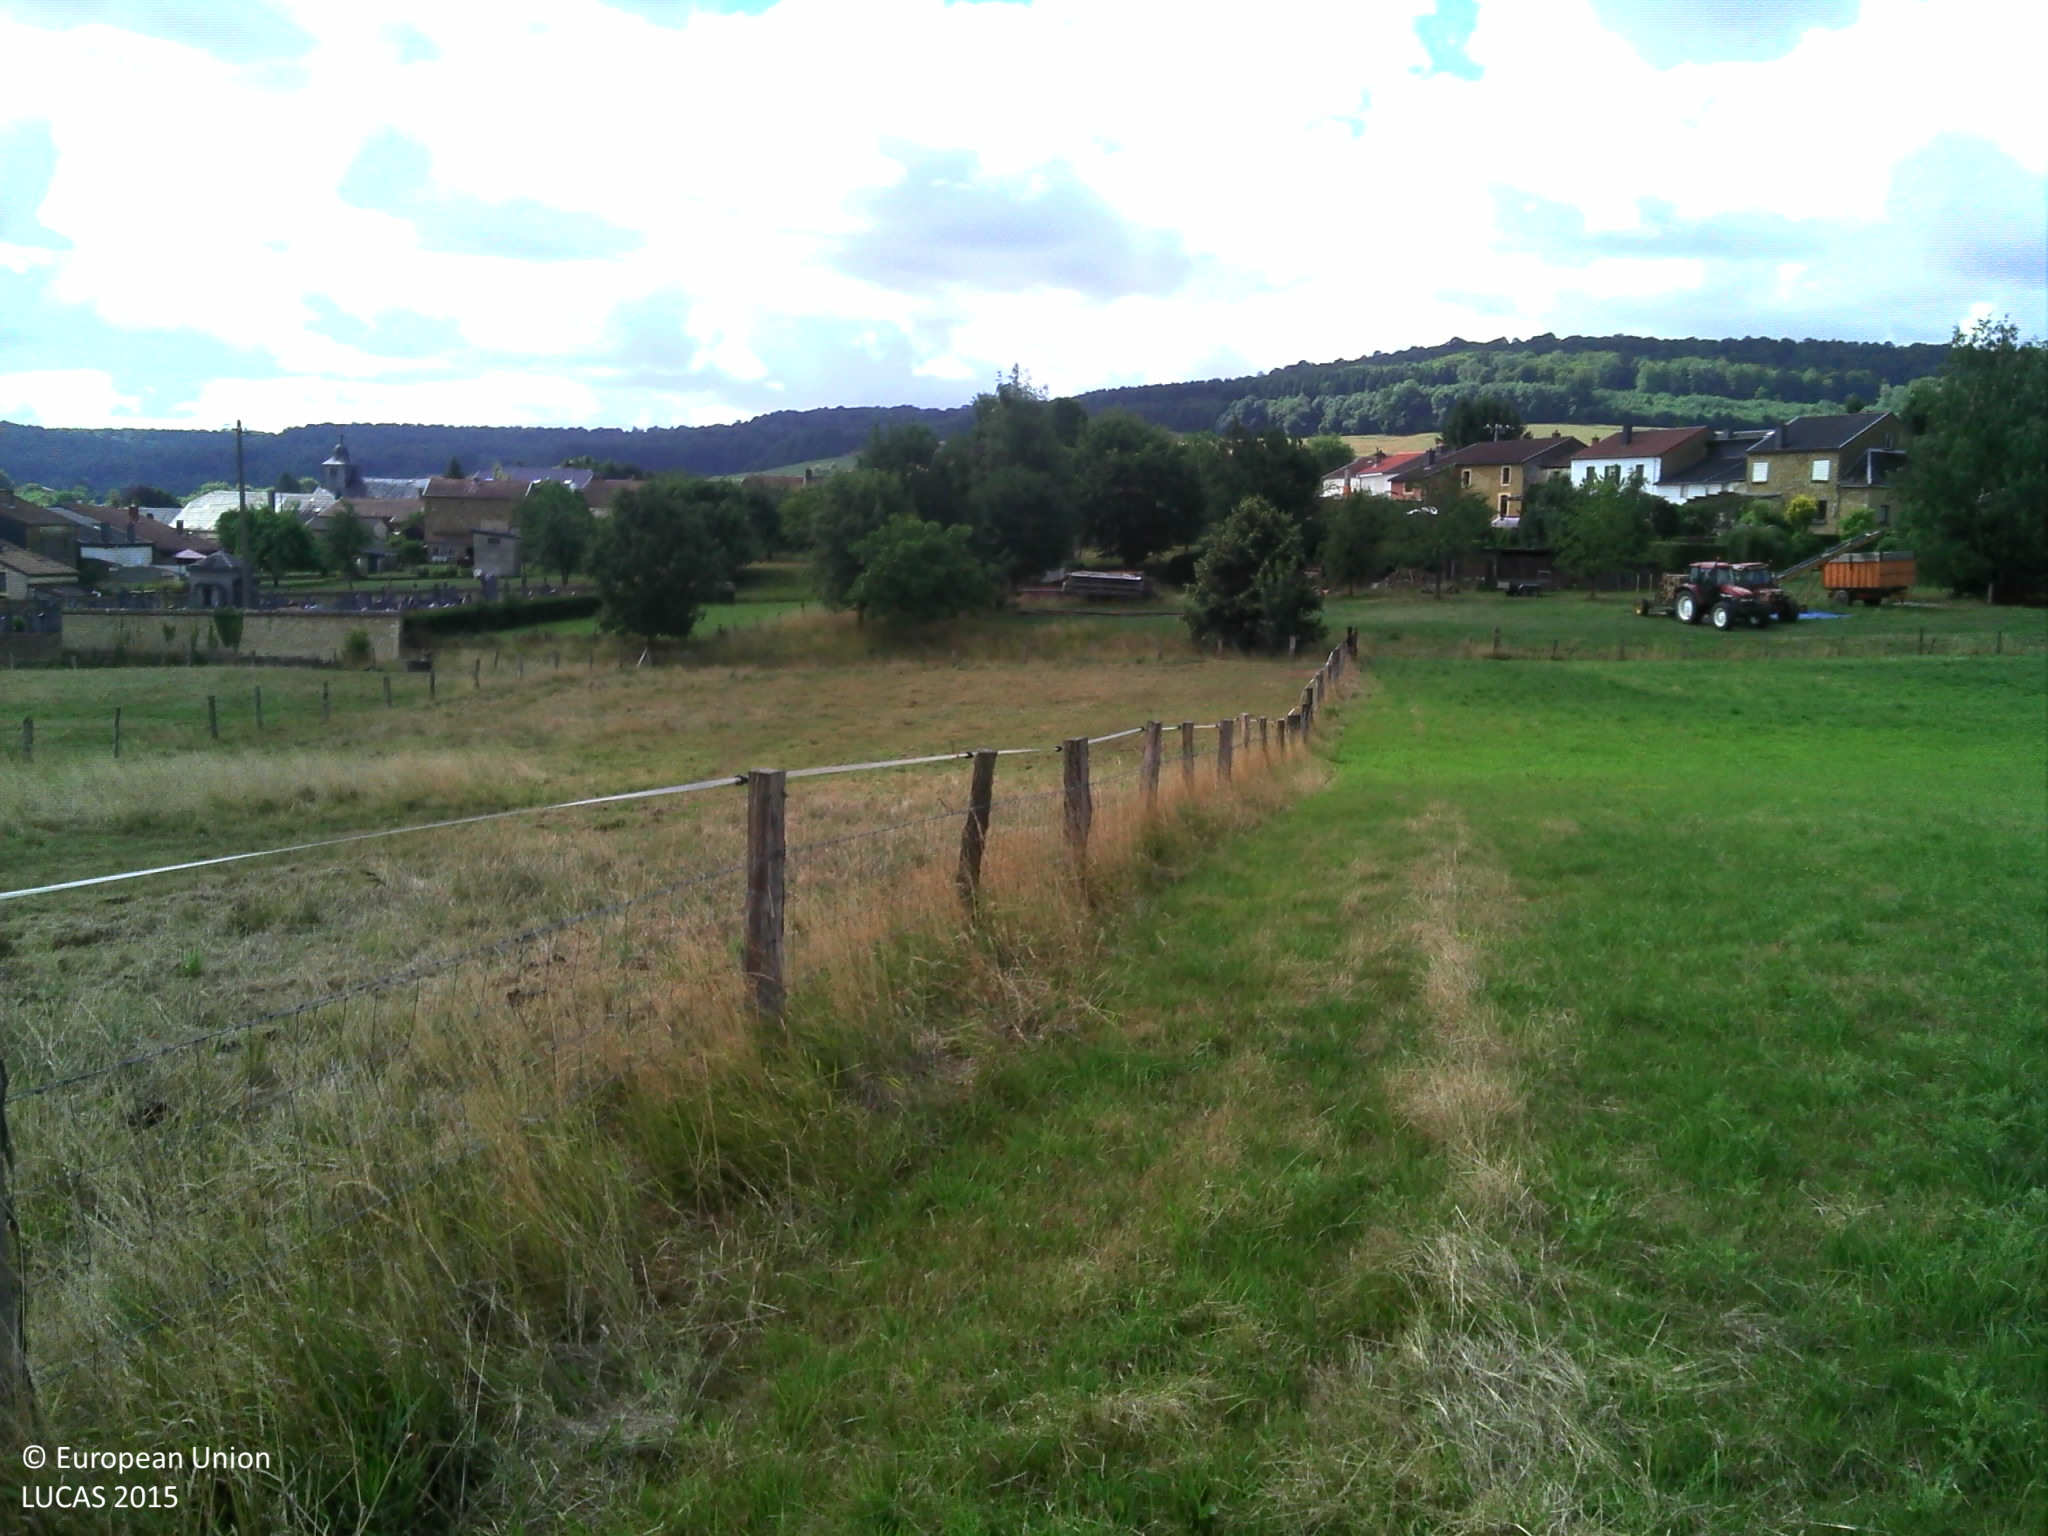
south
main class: Grassland
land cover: Grassland without tree/shrub cover
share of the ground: > 75 %
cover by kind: herbaceous plants 100 %
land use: Agriculture (excluding fallow land and kitchen gardens)
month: July
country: BE
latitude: 49.5407
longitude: 5.5903
